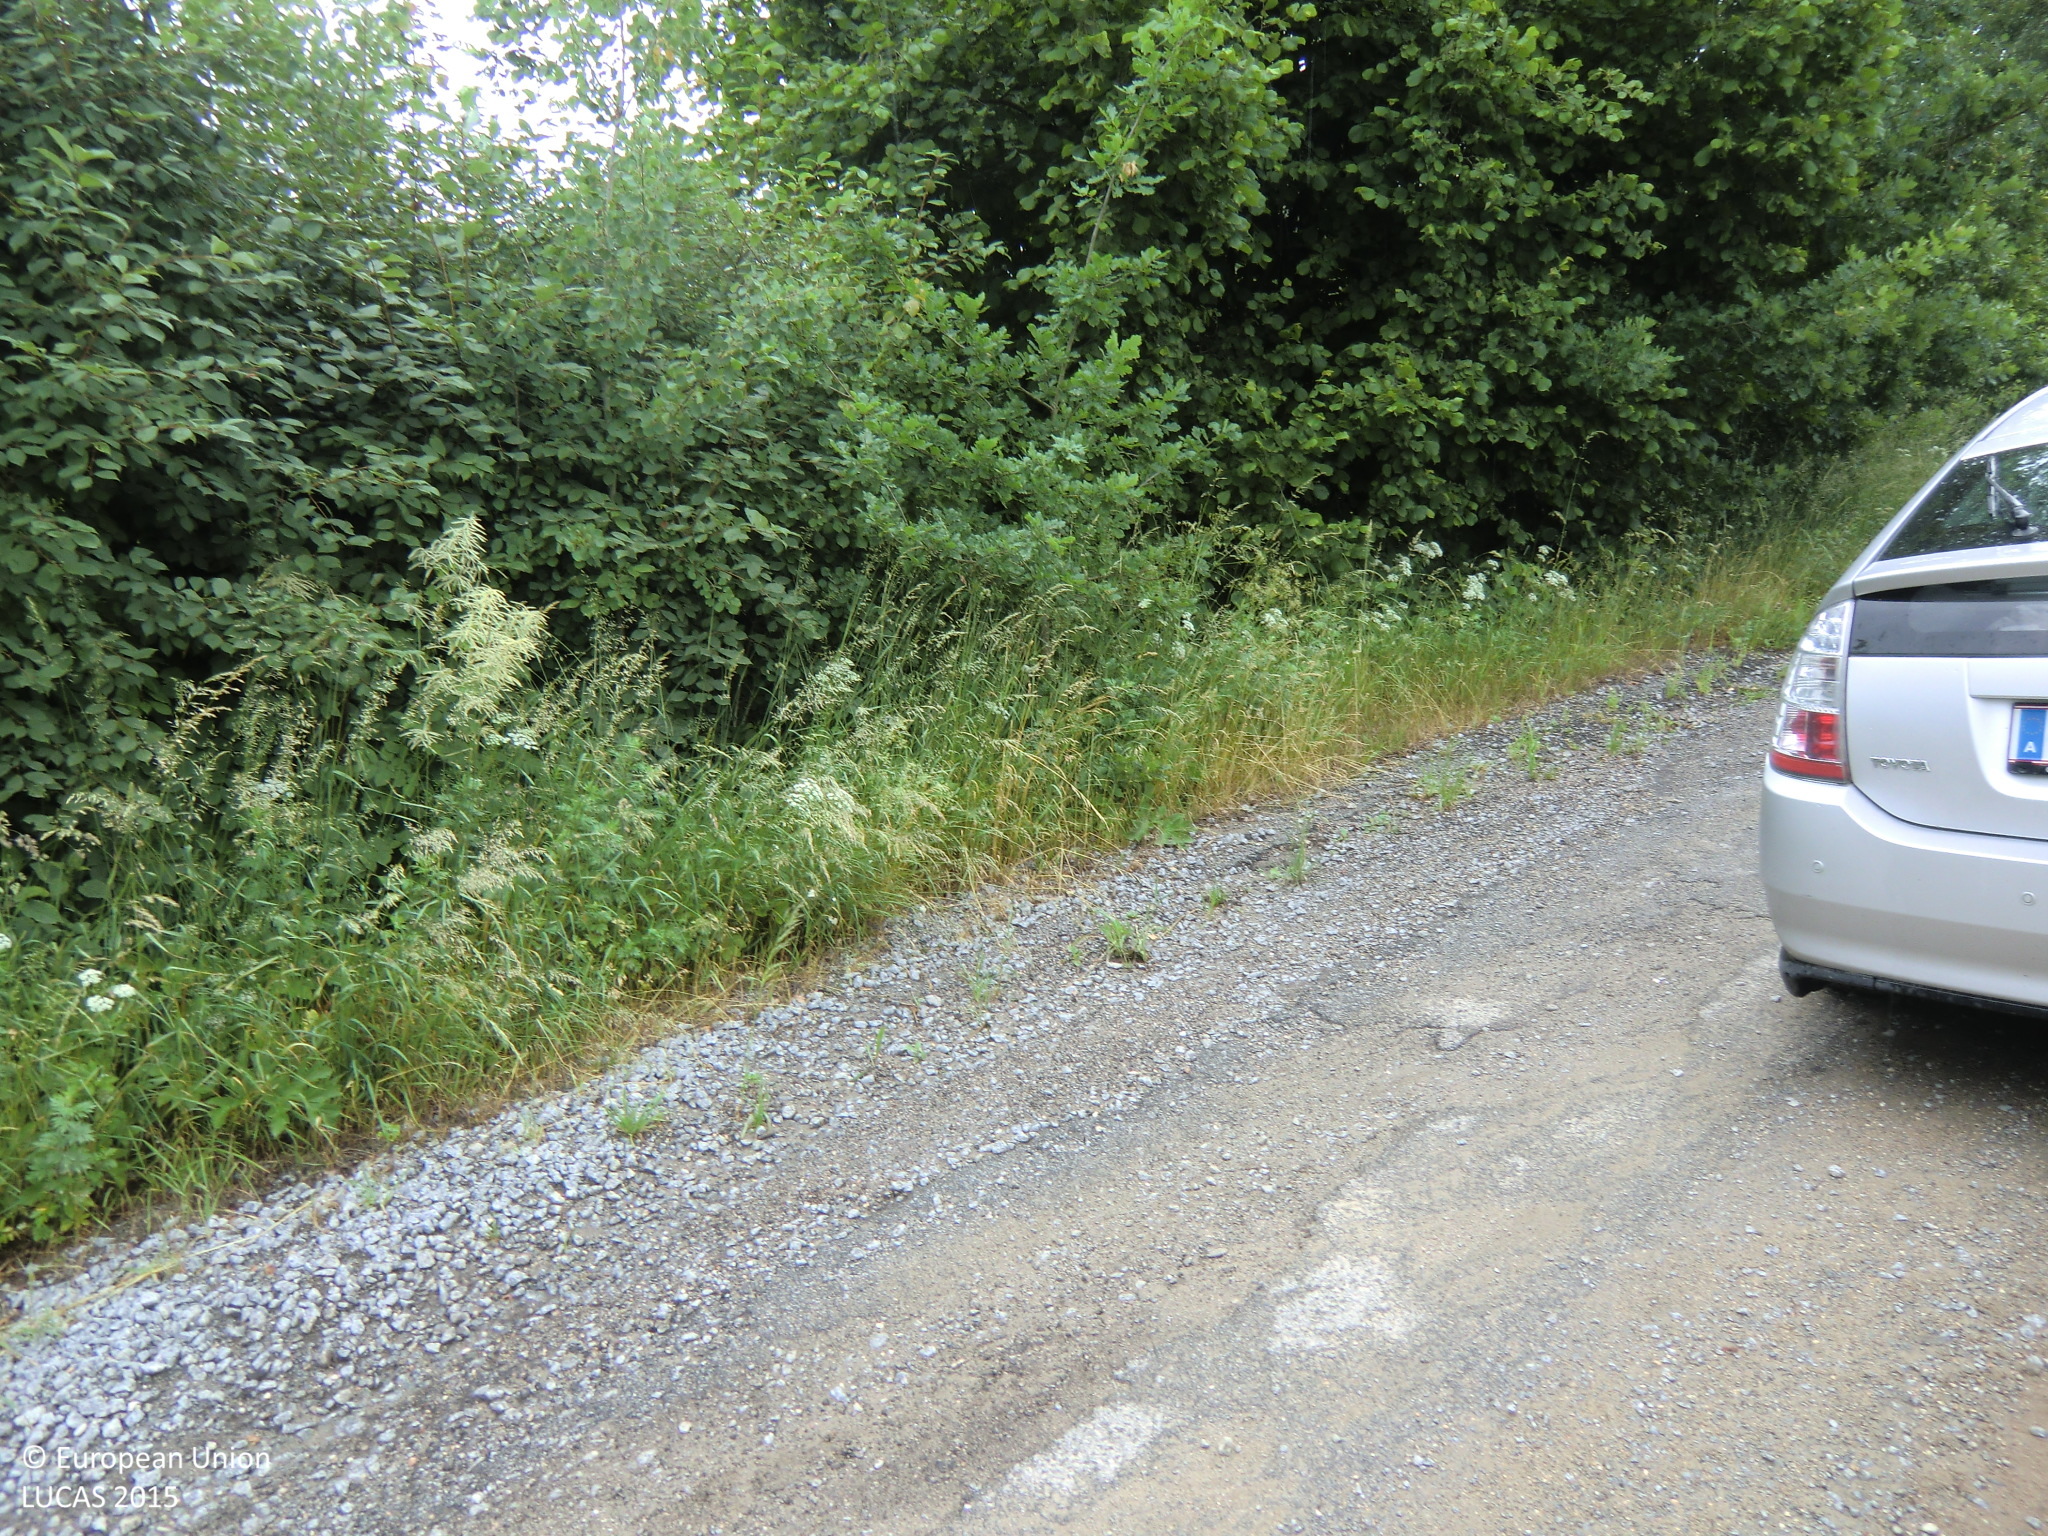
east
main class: Cropland
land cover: Rye
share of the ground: > 75 %
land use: Agriculture (excluding fallow land and kitchen gardens)
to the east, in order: Rye; Paved roads, cycling and walking lanes; Broadleaved woodland; Tracks; Rivers and streams; Grassland without tree/shrub cover; Spruce dominated mixed woodland; Tracks; Spruce dominated mixed woodland; Rye; Triticale
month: June
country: AT
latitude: 48.4717
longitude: 14.5591
